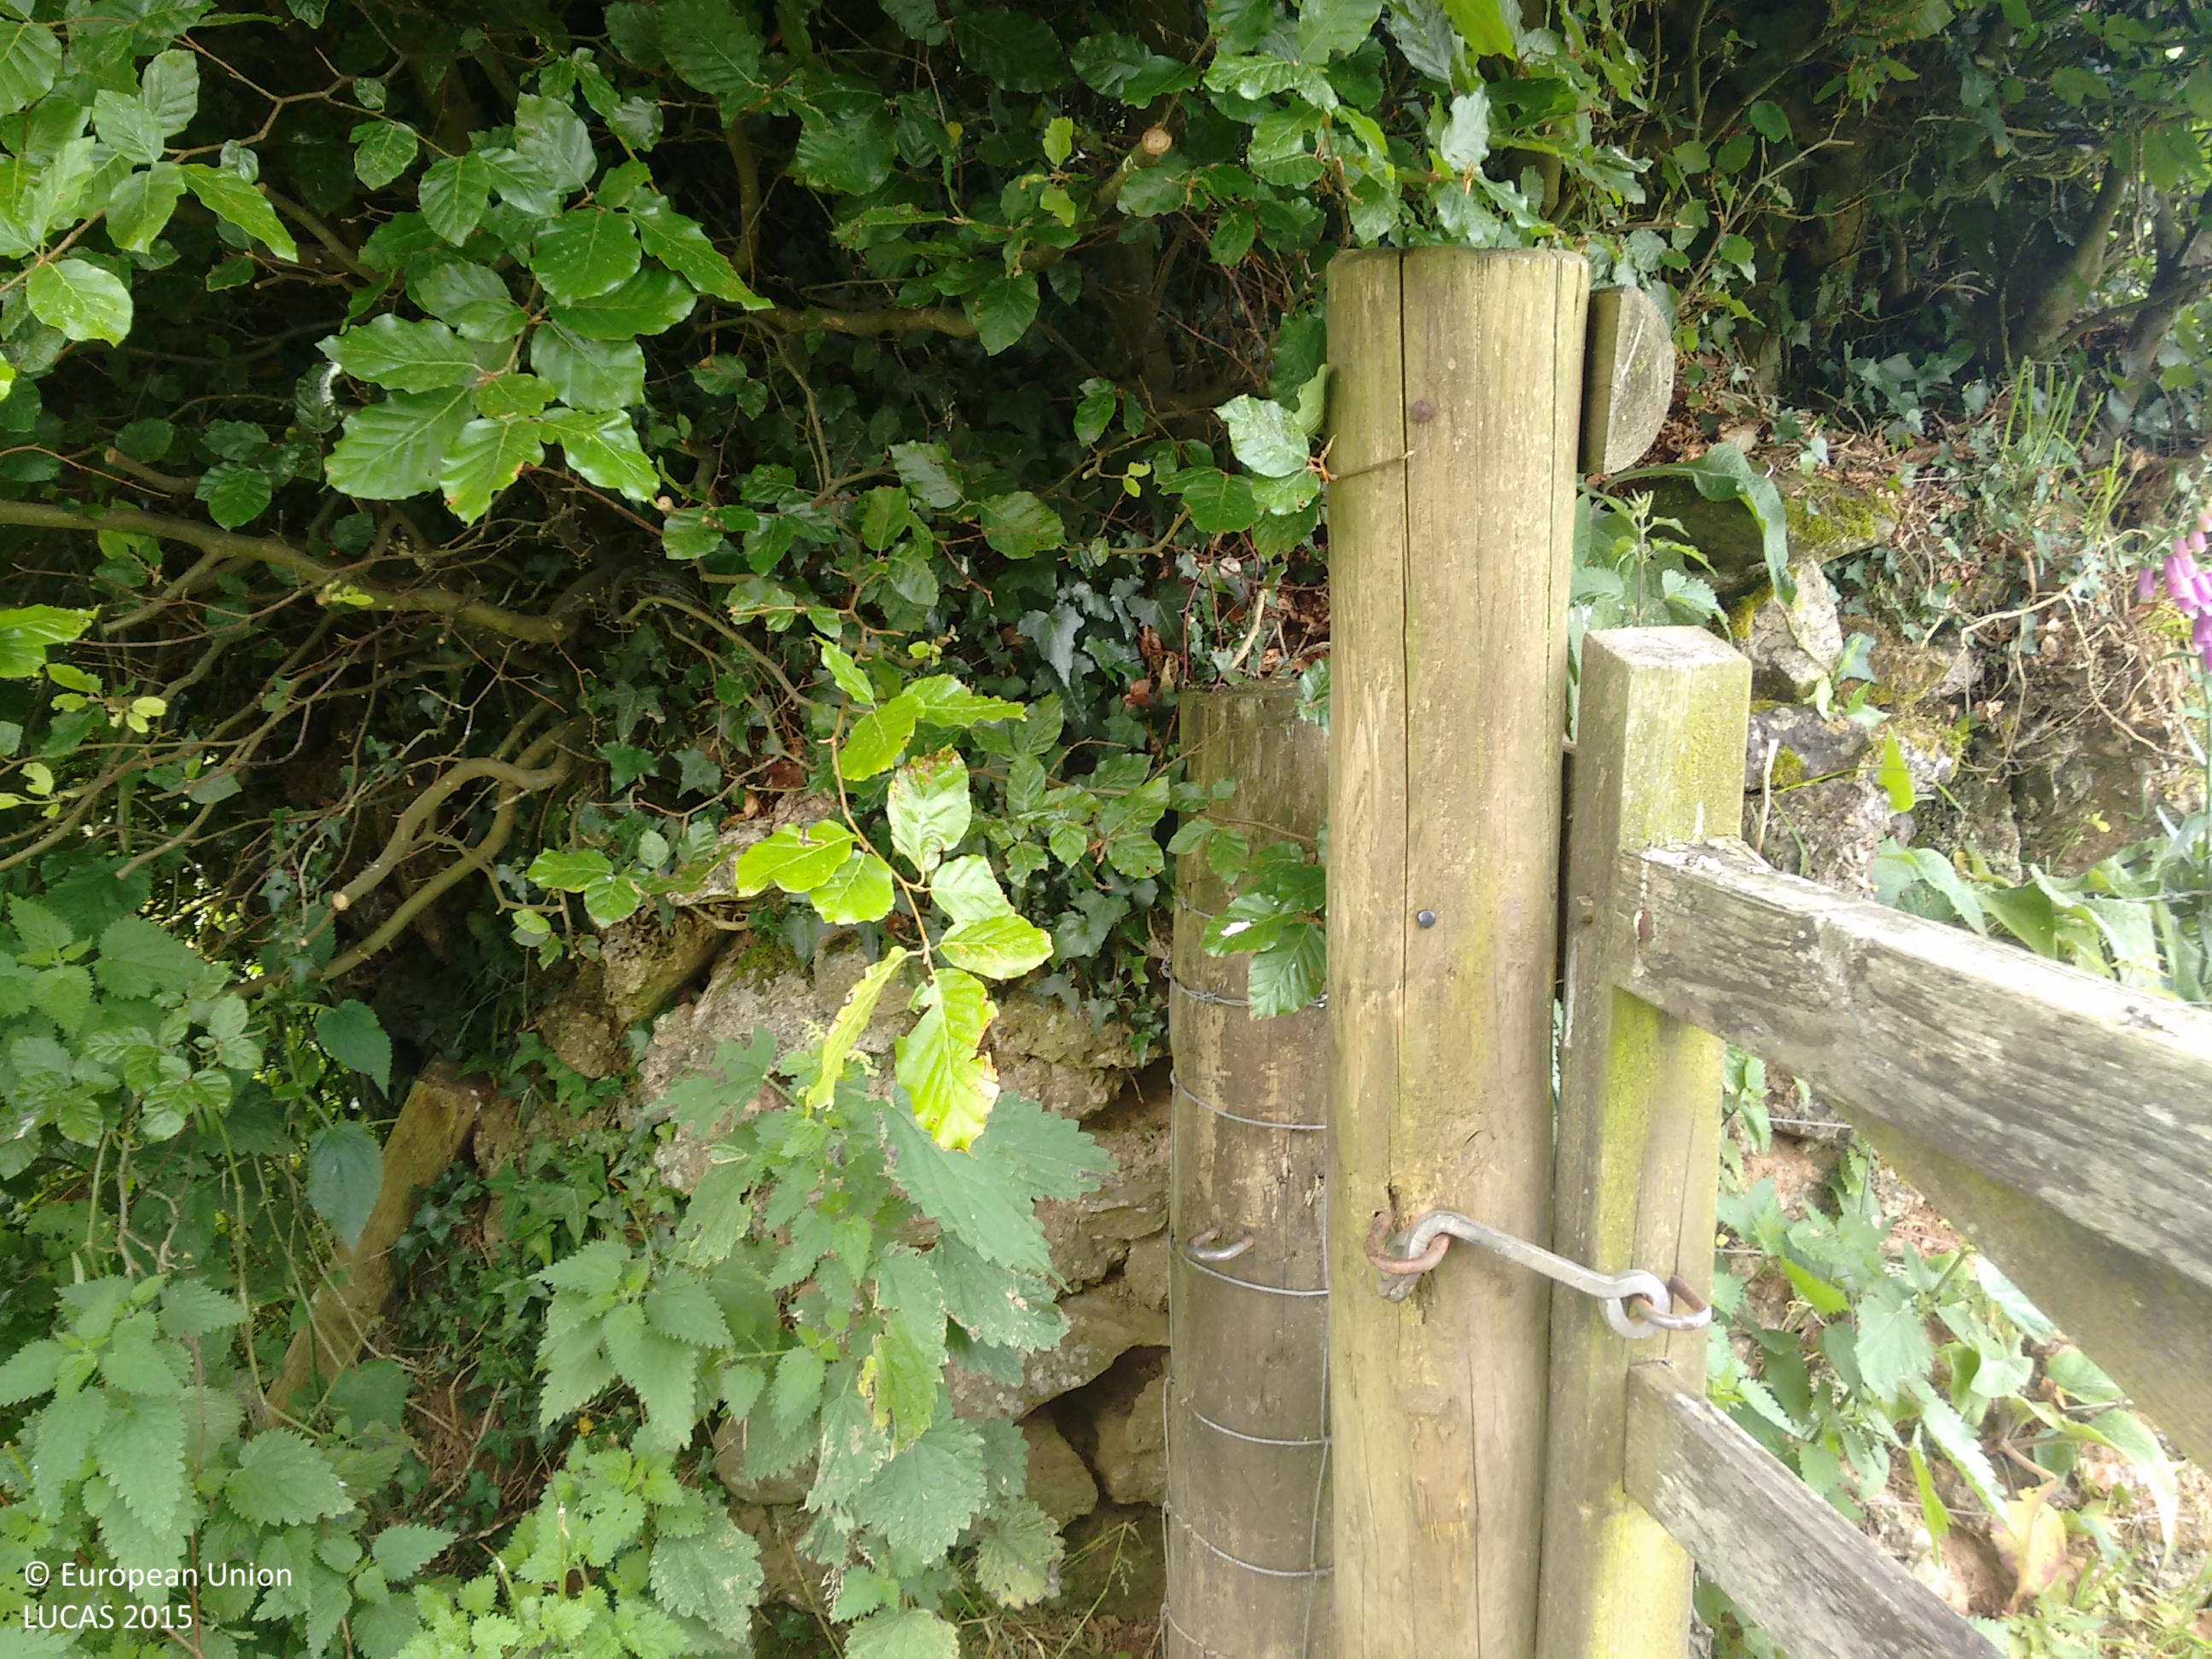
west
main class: Grassland
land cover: Grassland without tree/shrub cover
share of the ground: > 75 %
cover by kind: herbaceous plants 100 %
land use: Agriculture (excluding fallow land and kitchen gardens)
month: July
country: GB
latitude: 51.1415
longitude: -3.5350
